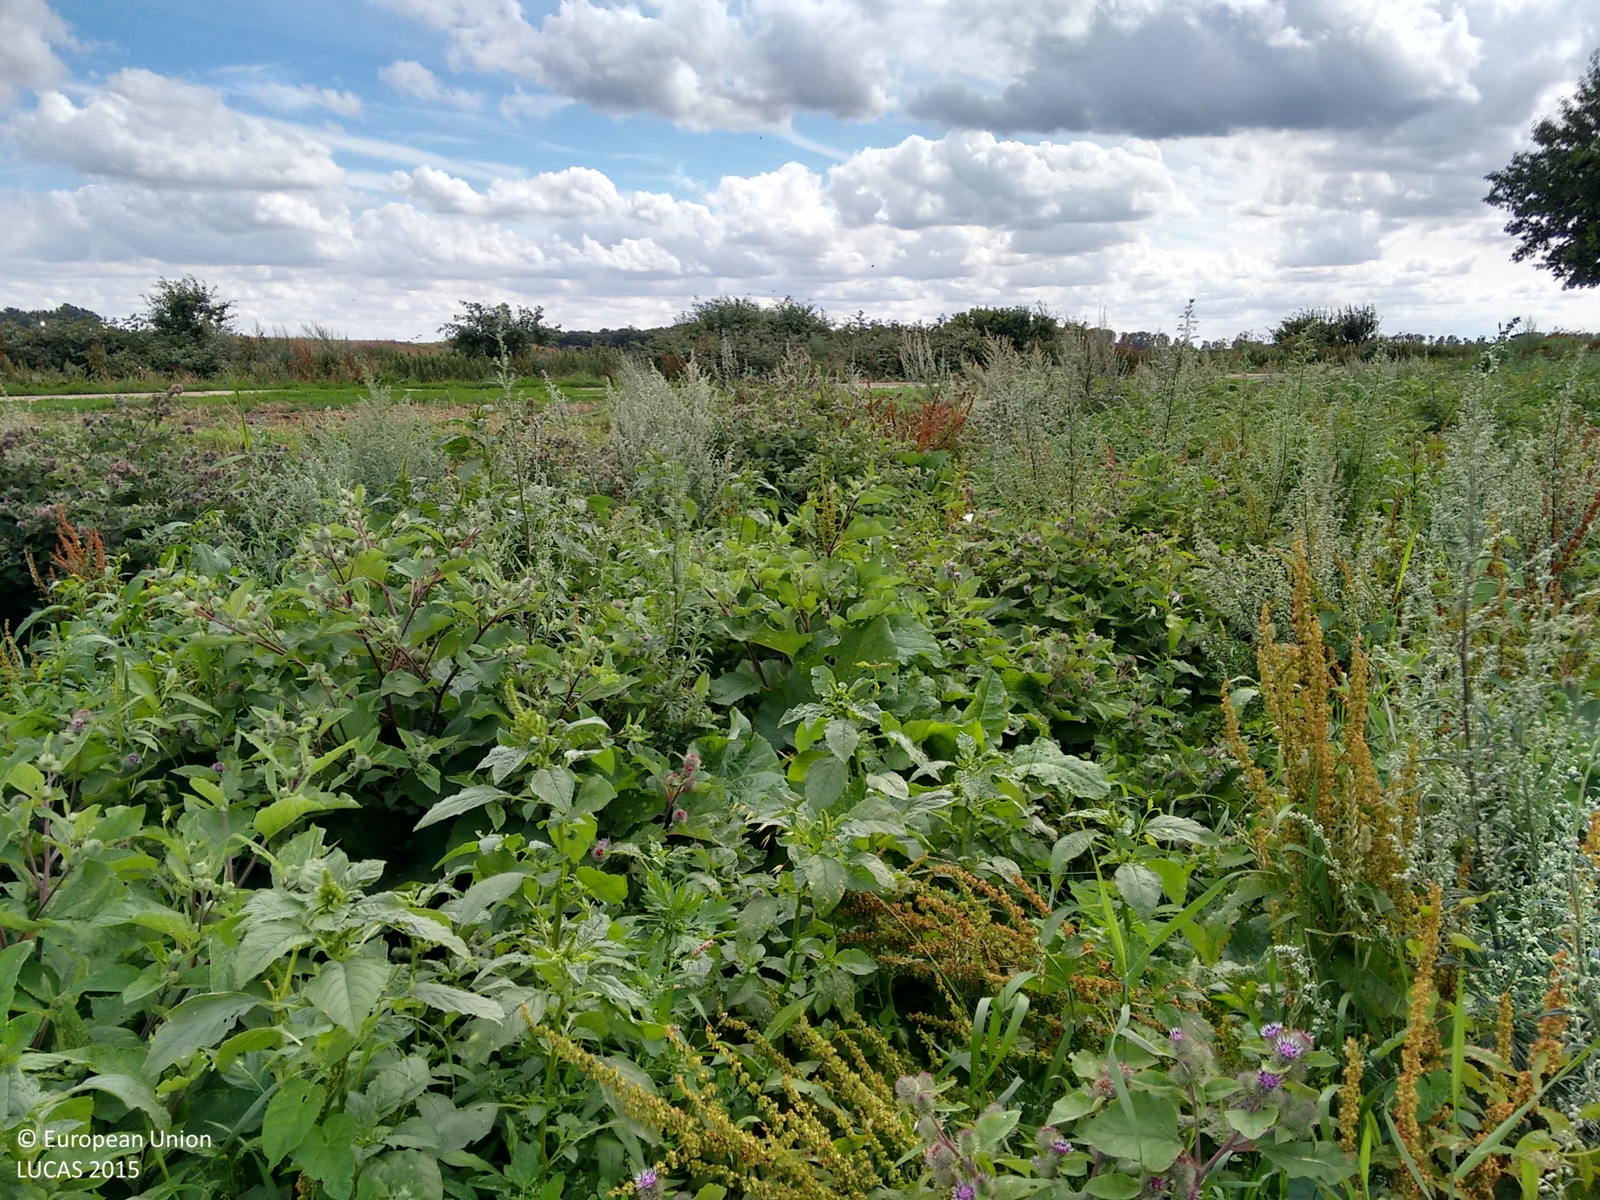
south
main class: Cropland
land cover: Common wheat
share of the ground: > 75 %
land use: Agriculture (excluding fallow land and kitchen gardens)
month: August
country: GB
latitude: 52.4802
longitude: 0.4454
